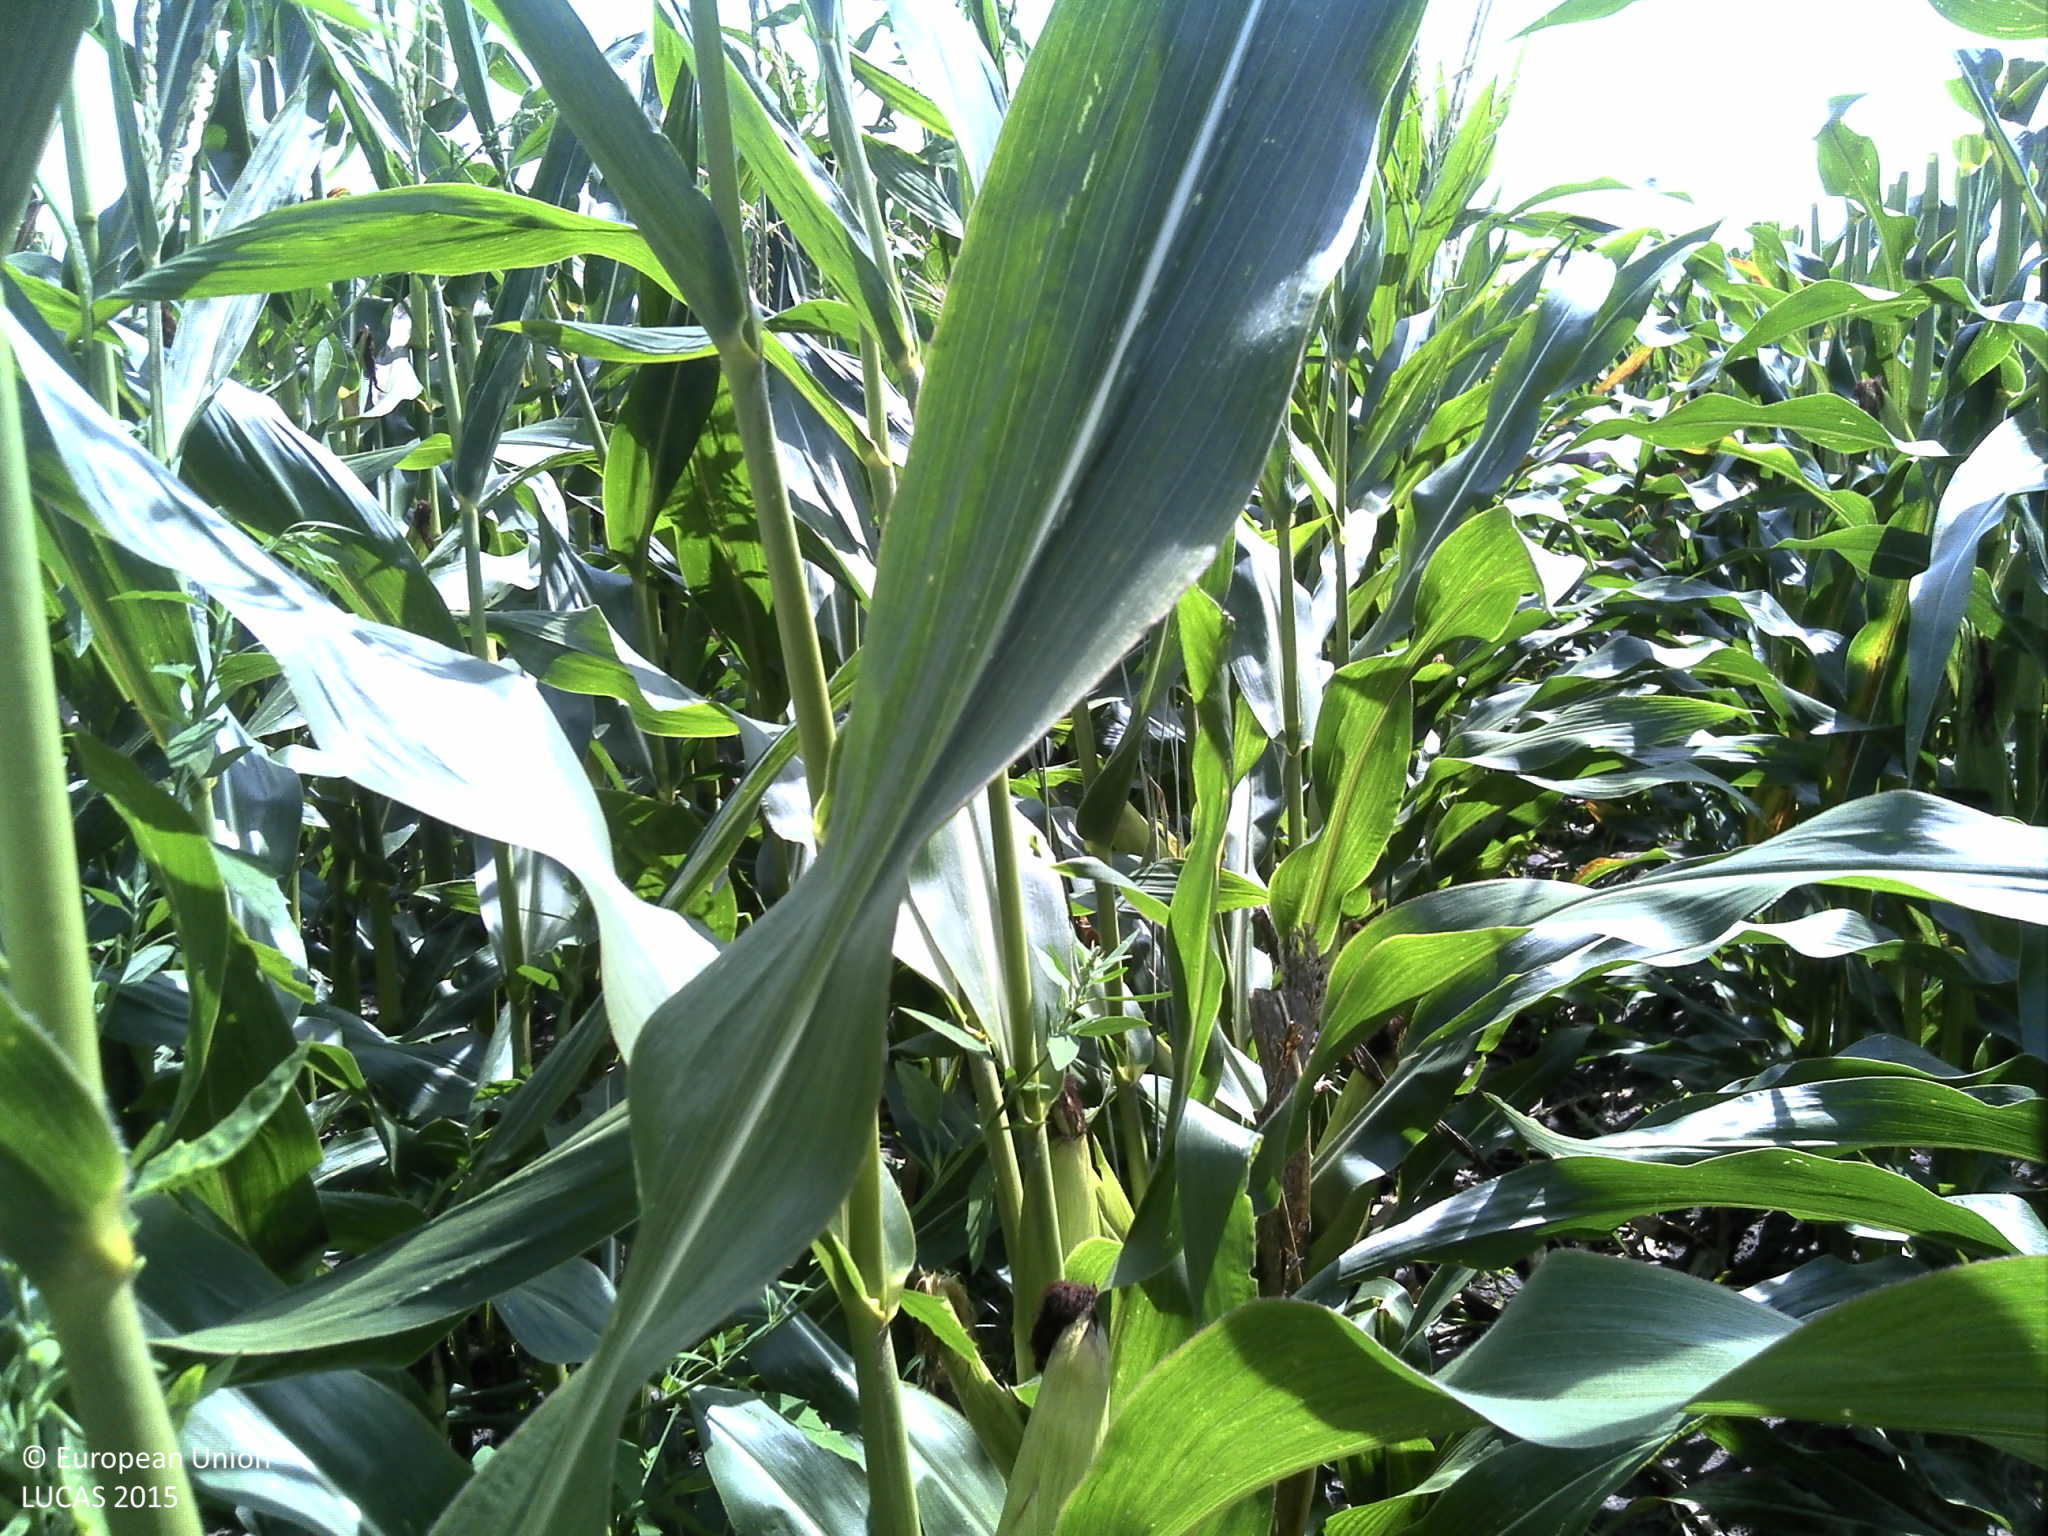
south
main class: Cropland
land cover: Maize
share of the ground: > 75 %
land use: Agriculture (excluding fallow land and kitchen gardens)
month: July
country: FR
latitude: 44.2526
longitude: -0.3200
